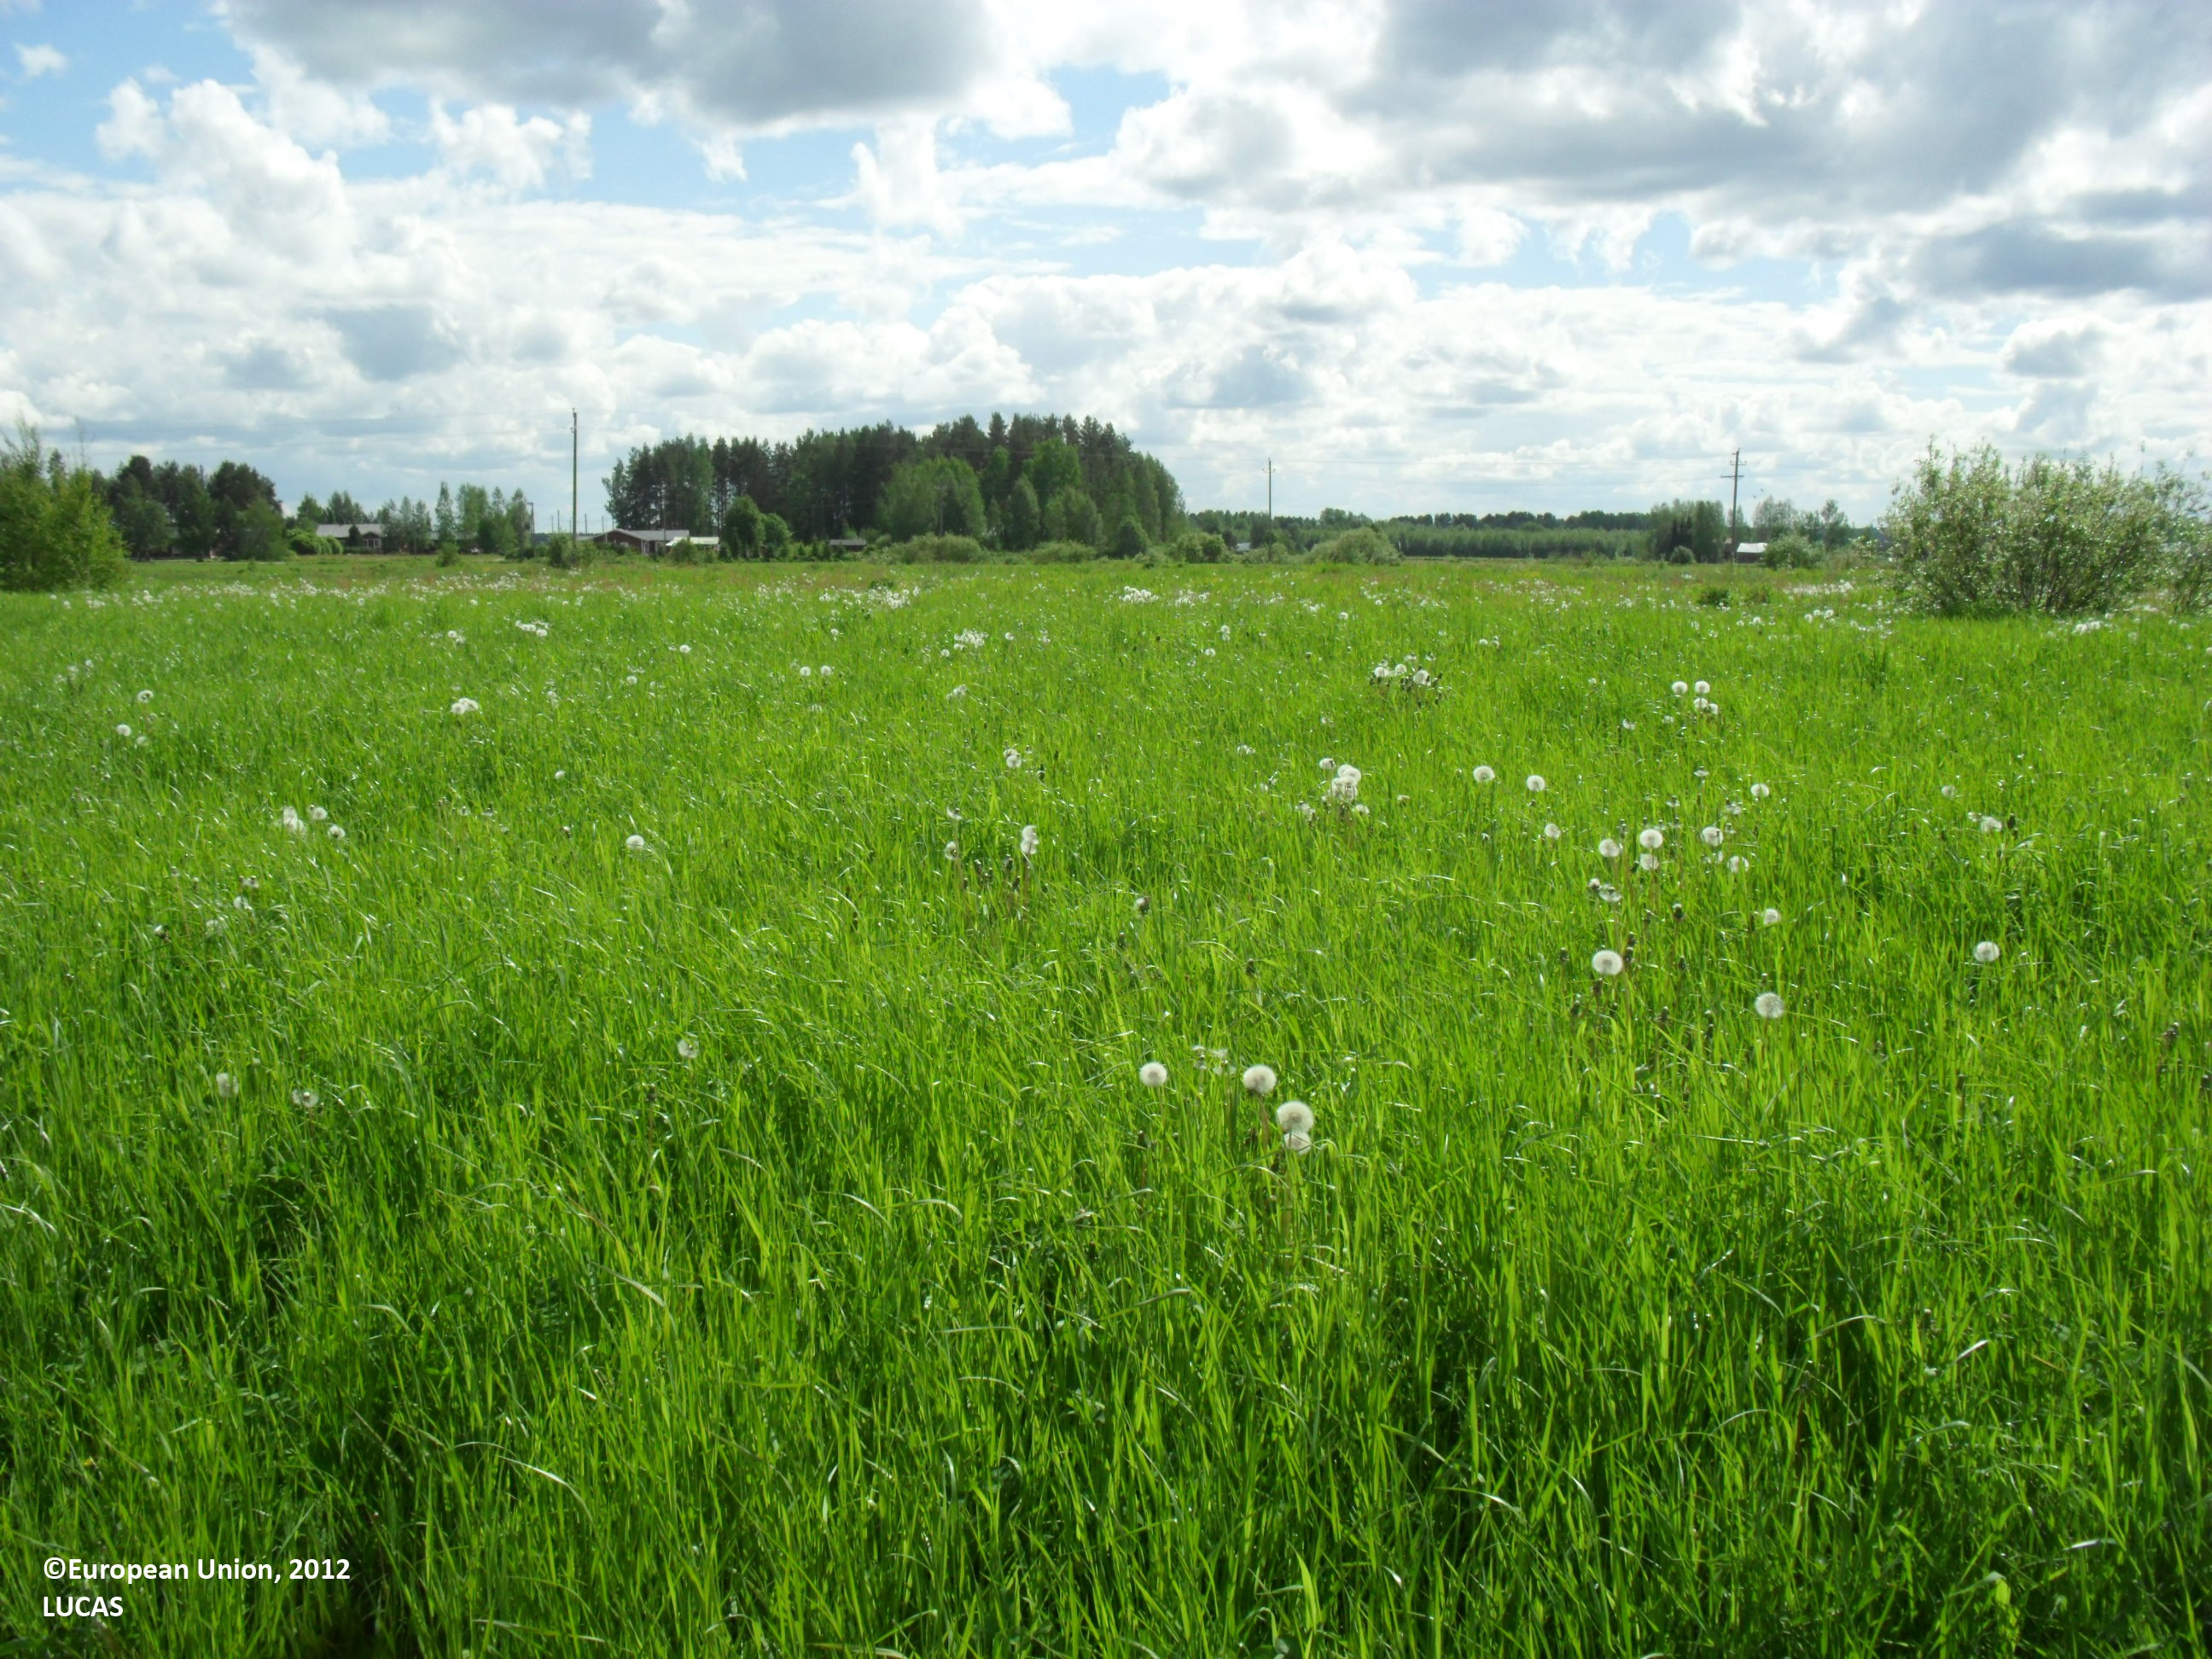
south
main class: Cropland
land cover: Barley
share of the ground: < 10 %
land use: Agriculture (excluding fallow land and kitchen gardens)
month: June
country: FI
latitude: 62.8463
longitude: 23.4822
